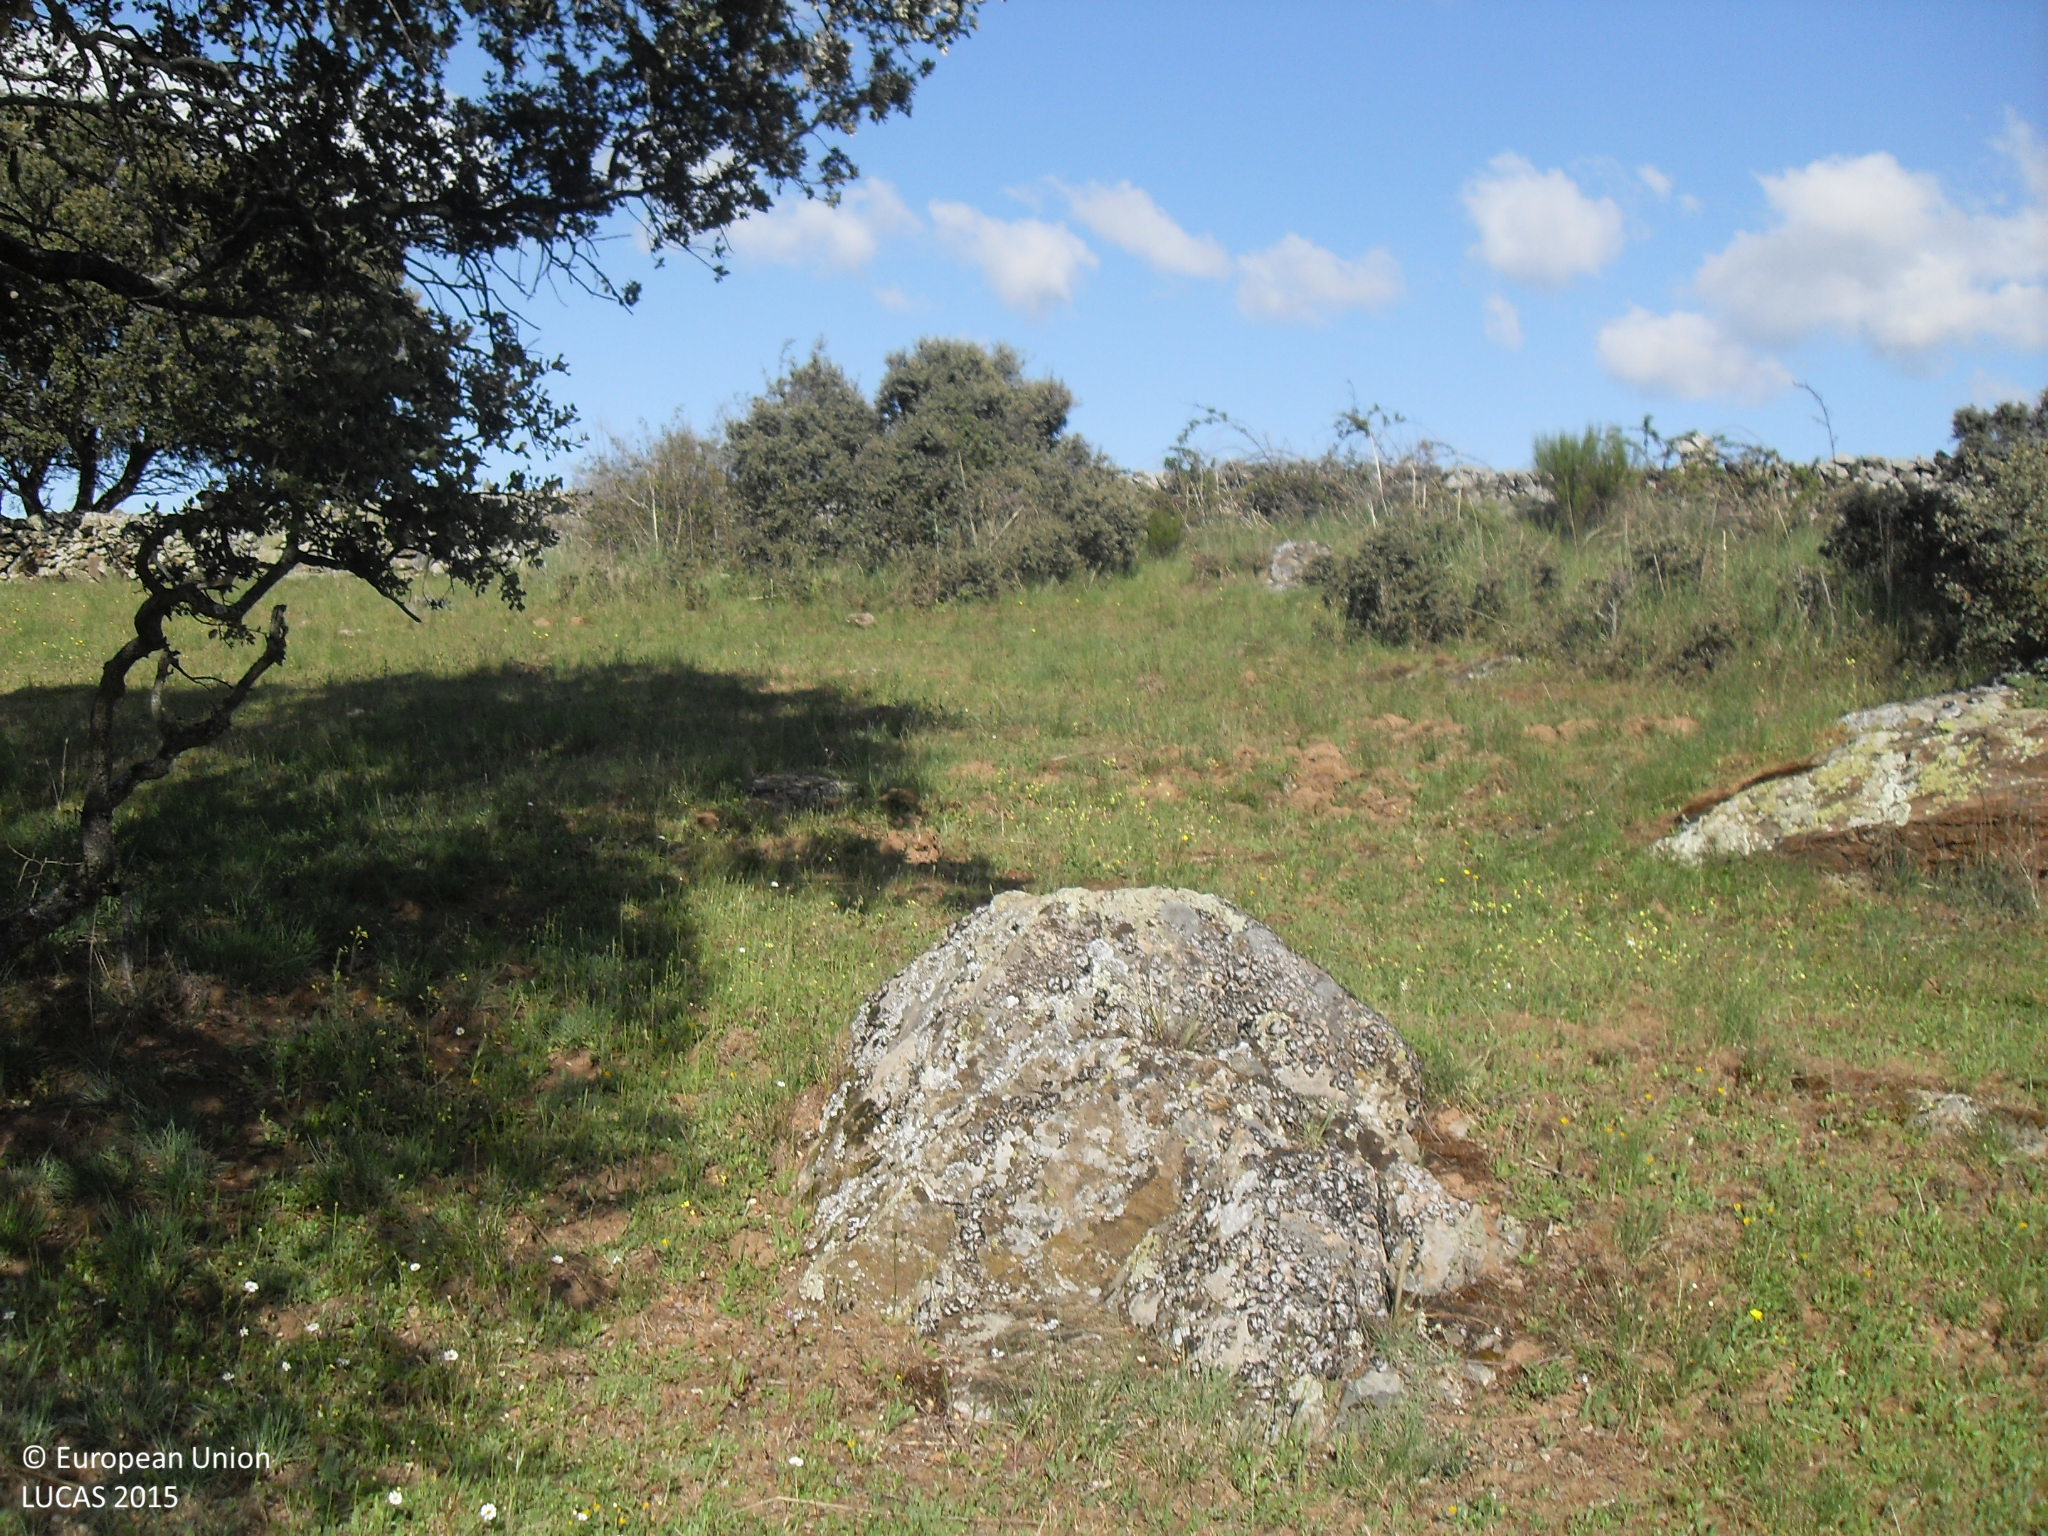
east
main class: Woodland
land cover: Broadleaved woodland
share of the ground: 10 - 25 %
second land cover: Grassland without tree/shrub cover
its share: > 75 %
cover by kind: herbaceous plants 85 %, broadleaved forest trees 15 %
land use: Forestry
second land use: Agriculture (excluding fallow land and kitchen gardens)
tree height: < 5 m
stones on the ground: < 10 %
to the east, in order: Broadleaved woodland; Grassland without tree/shrub cover; Dry stone walls; Broadleaved woodland; Groves; Dry stone walls; Grass margins; Tracks; Grass margins; Dry stone walls; Broadleaved woodland; Dry stone walls; Broadleaved woodland
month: May
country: ES
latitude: 40.6418
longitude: -5.2838
